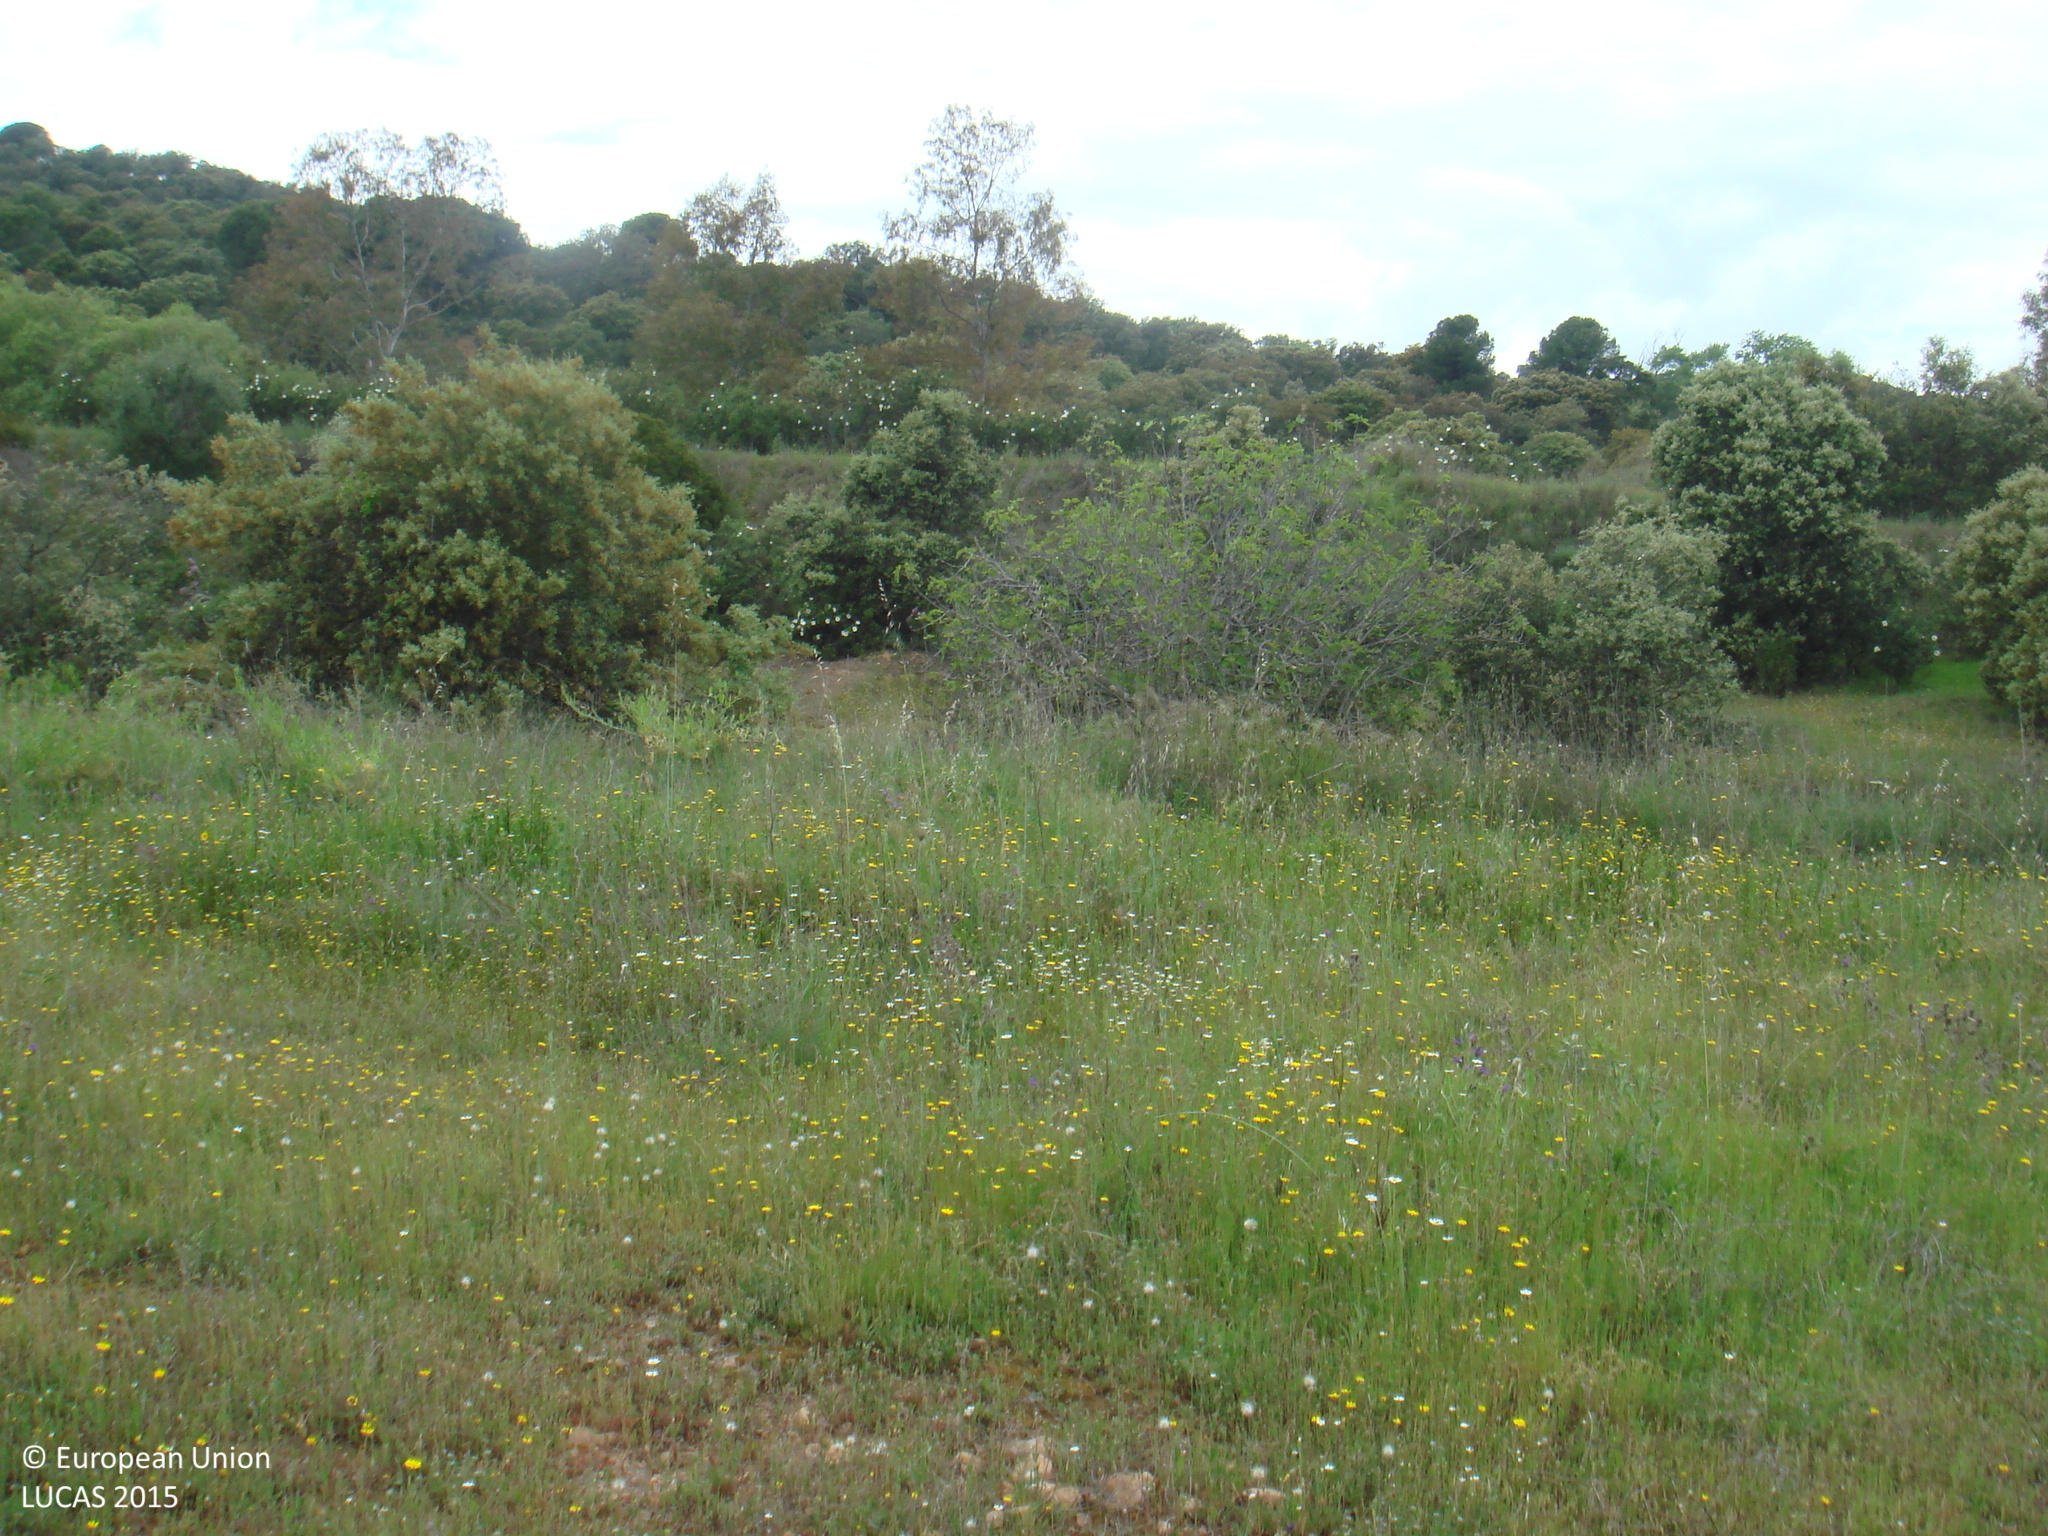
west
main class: Shrubland
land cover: Shrubland with sparse tree cover
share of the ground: > 75 %
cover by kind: shrubs 55 %, herbaceous plants 40 %, broadleaved forest trees 5 %
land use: Semi-natural and natural areas not in use
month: April
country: ES
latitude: 38.0332
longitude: -5.0481
